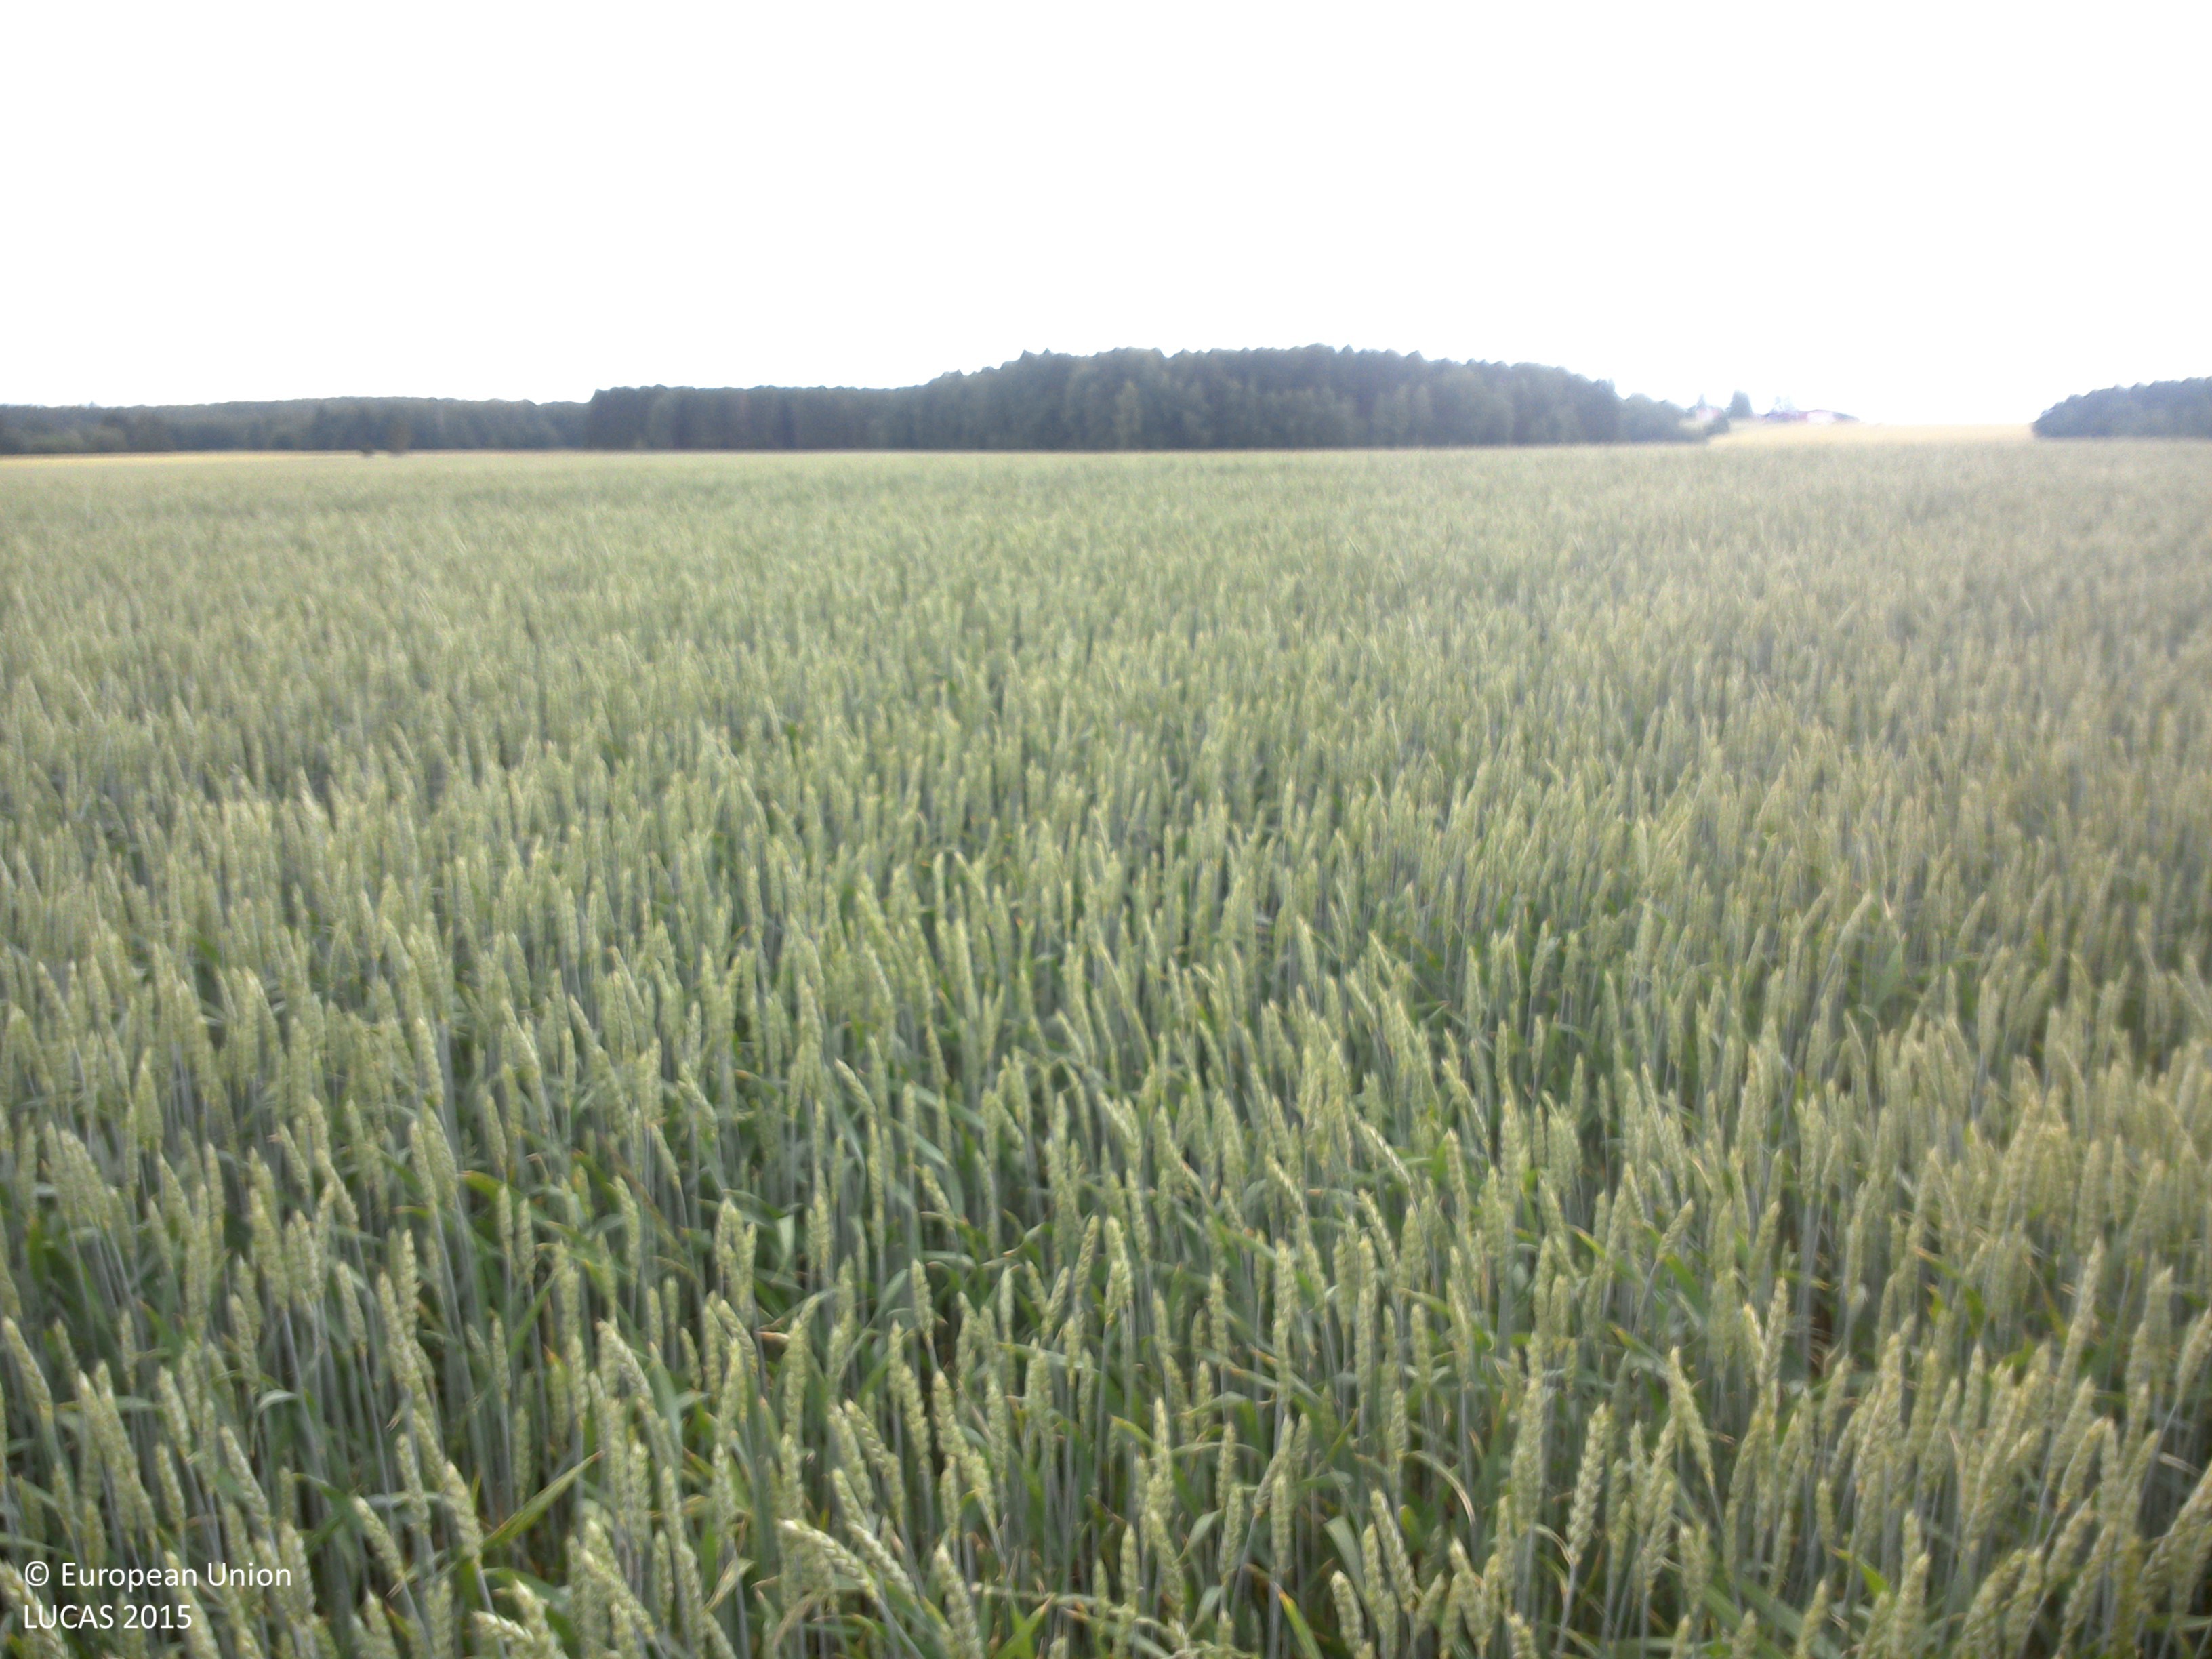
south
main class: Cropland
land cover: Common wheat
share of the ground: > 75 %
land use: Agriculture (excluding fallow land and kitchen gardens)
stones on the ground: < 10 %
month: July
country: SE
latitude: 58.5018
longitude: 15.0903
